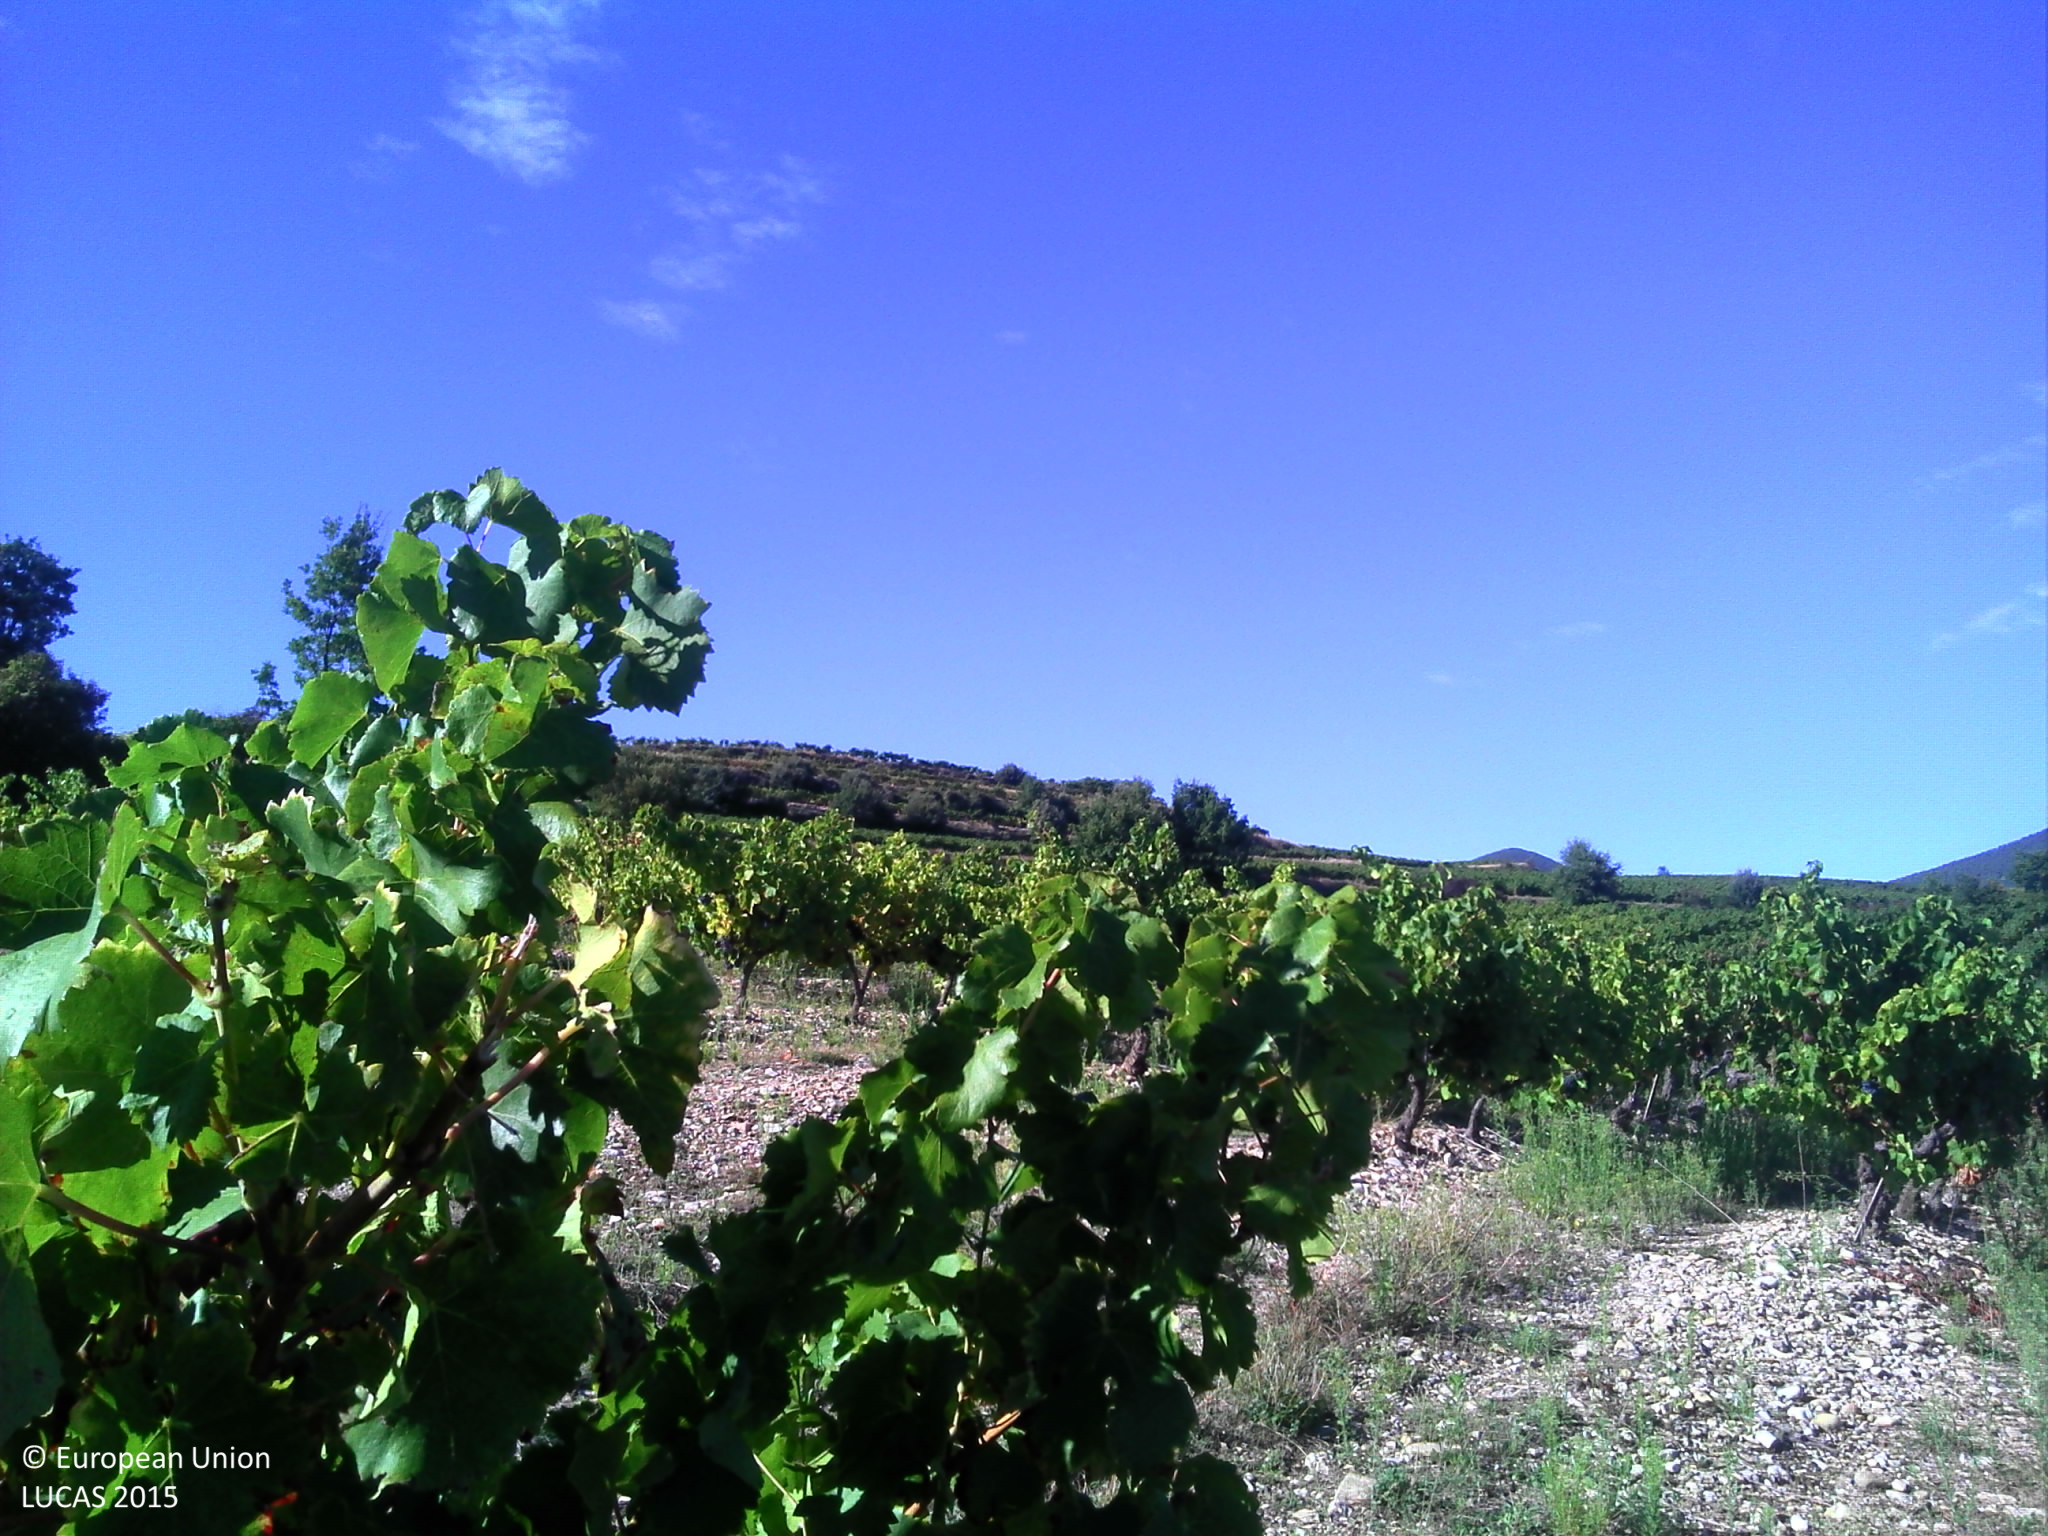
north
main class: Cropland
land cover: Vineyards
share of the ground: 10 - 25 %
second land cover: Spontaneously vegetated surfaces
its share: > 75 %
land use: Agriculture (excluding fallow land and kitchen gardens)
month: September
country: FR
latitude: 44.3614
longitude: 5.1014
